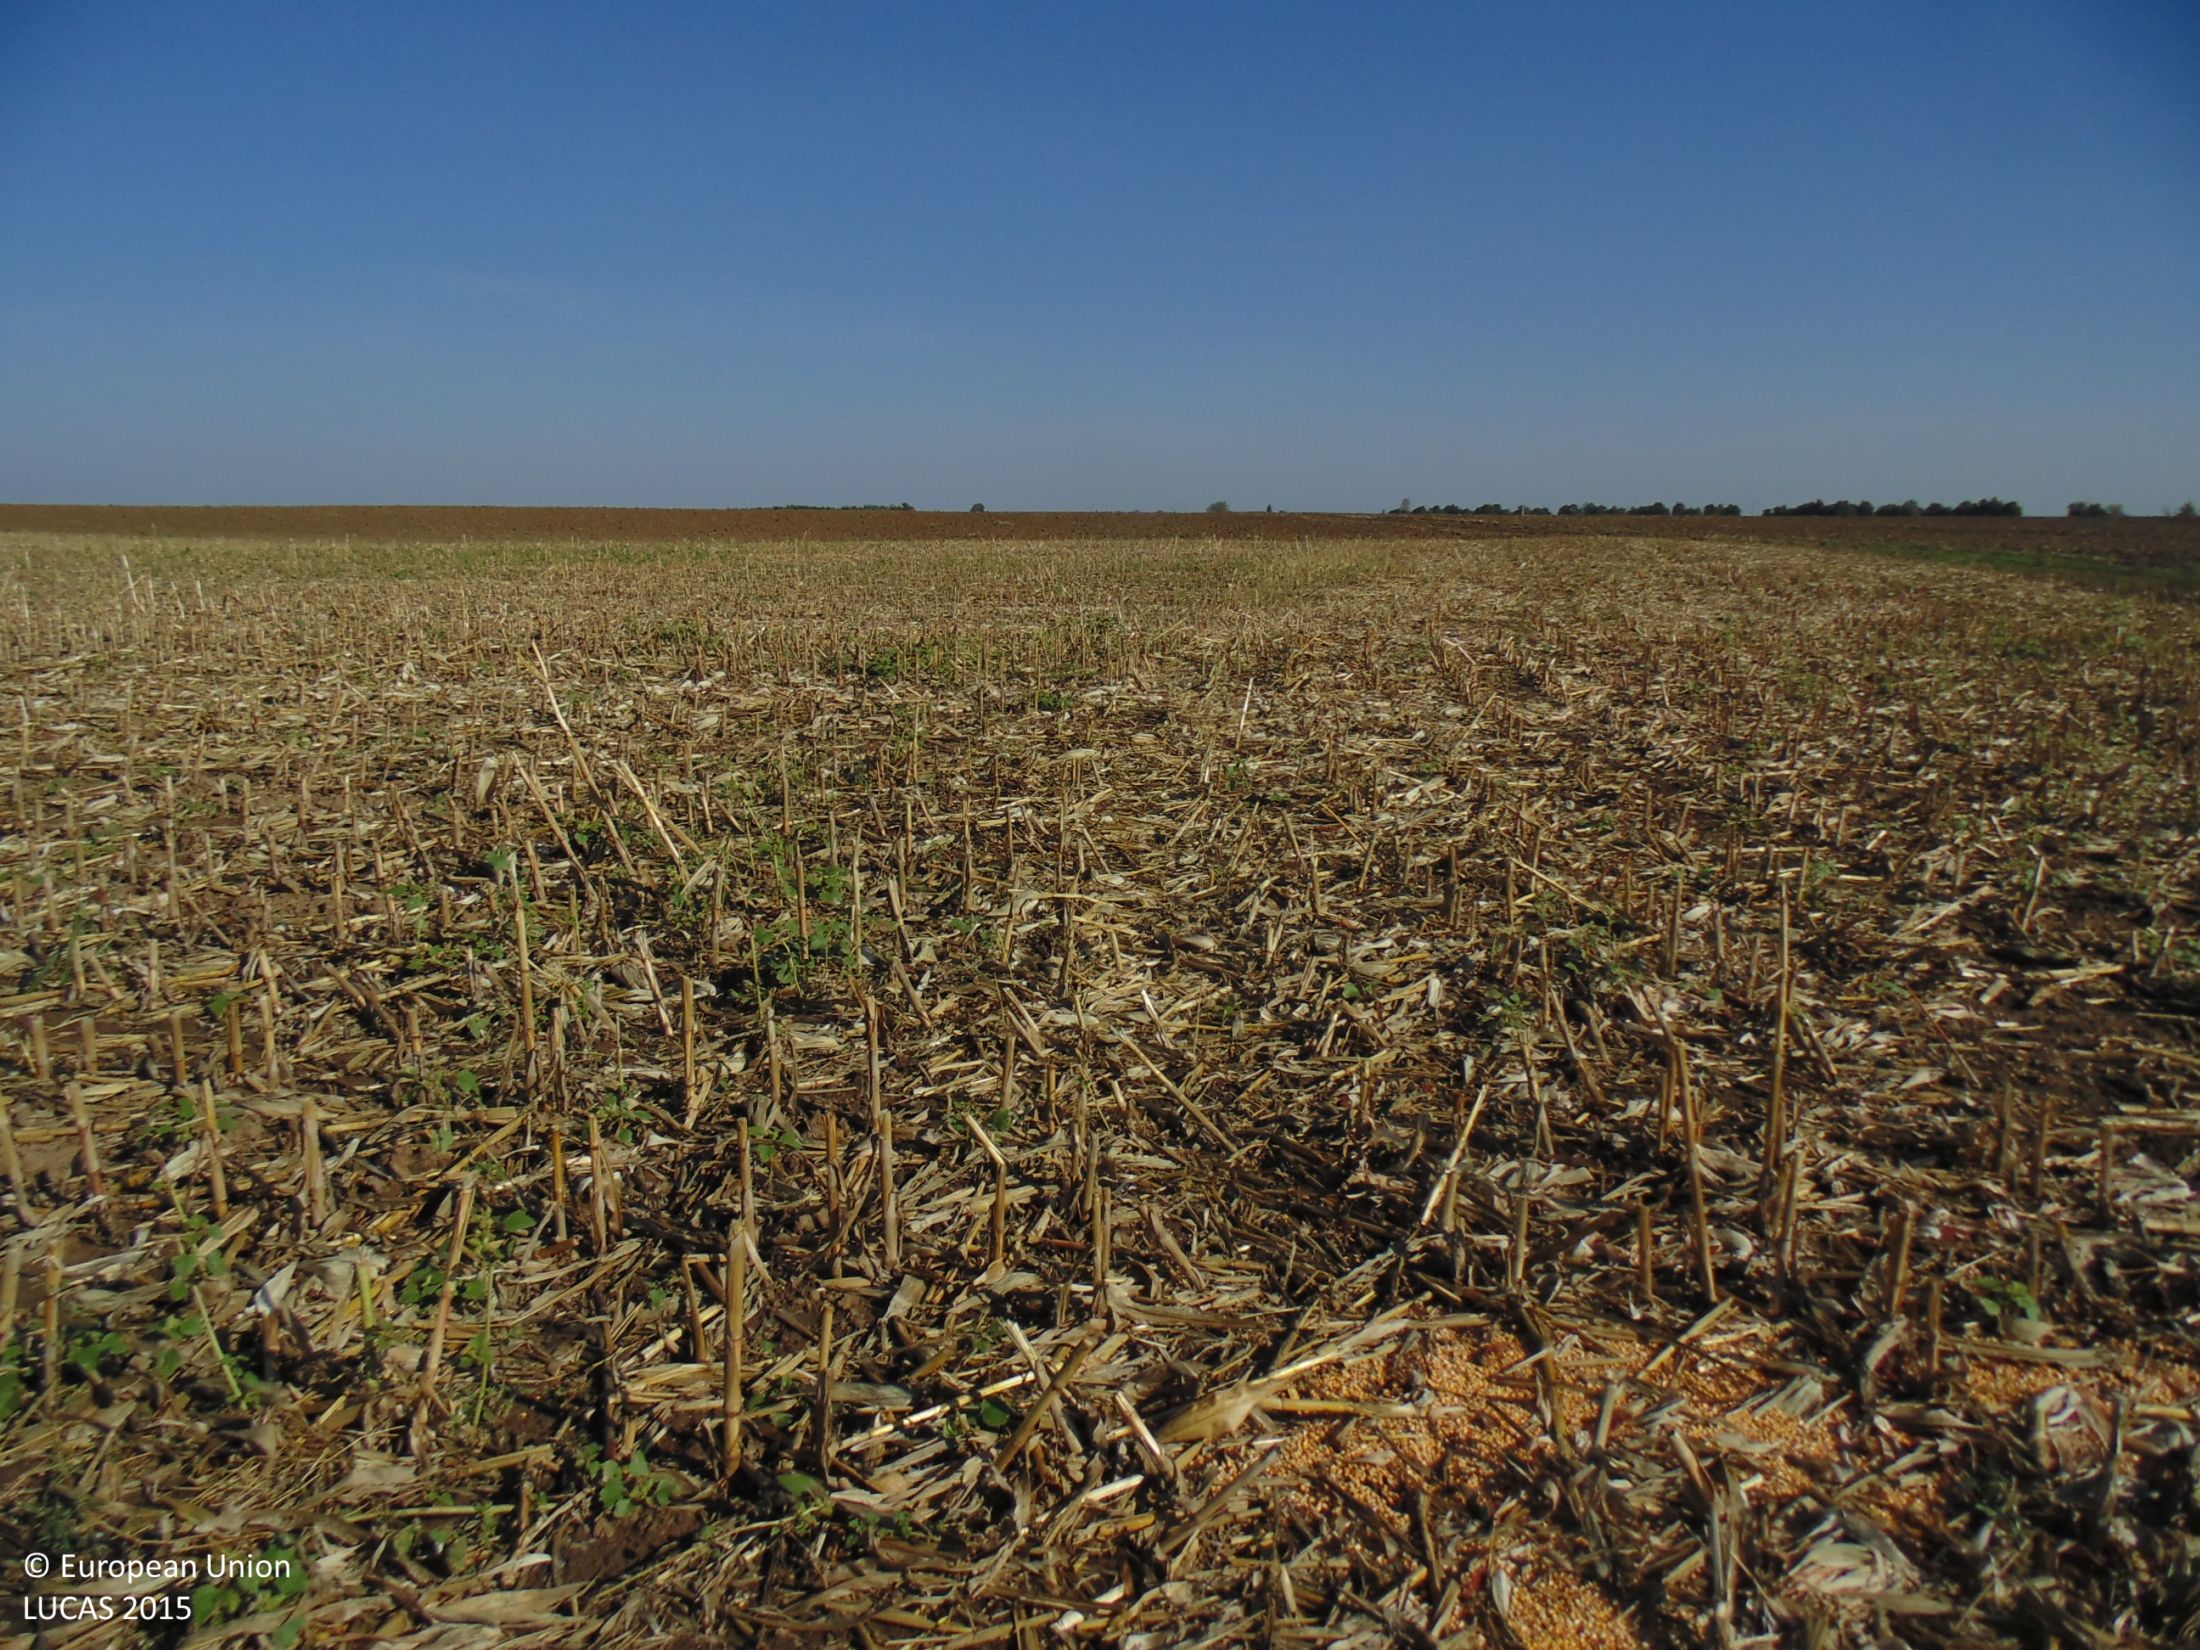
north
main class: Cropland
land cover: Maize
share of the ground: 10 - 25 %
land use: Agriculture (excluding fallow land and kitchen gardens)
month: September
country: BG
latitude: 44.1080
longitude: 27.0291
